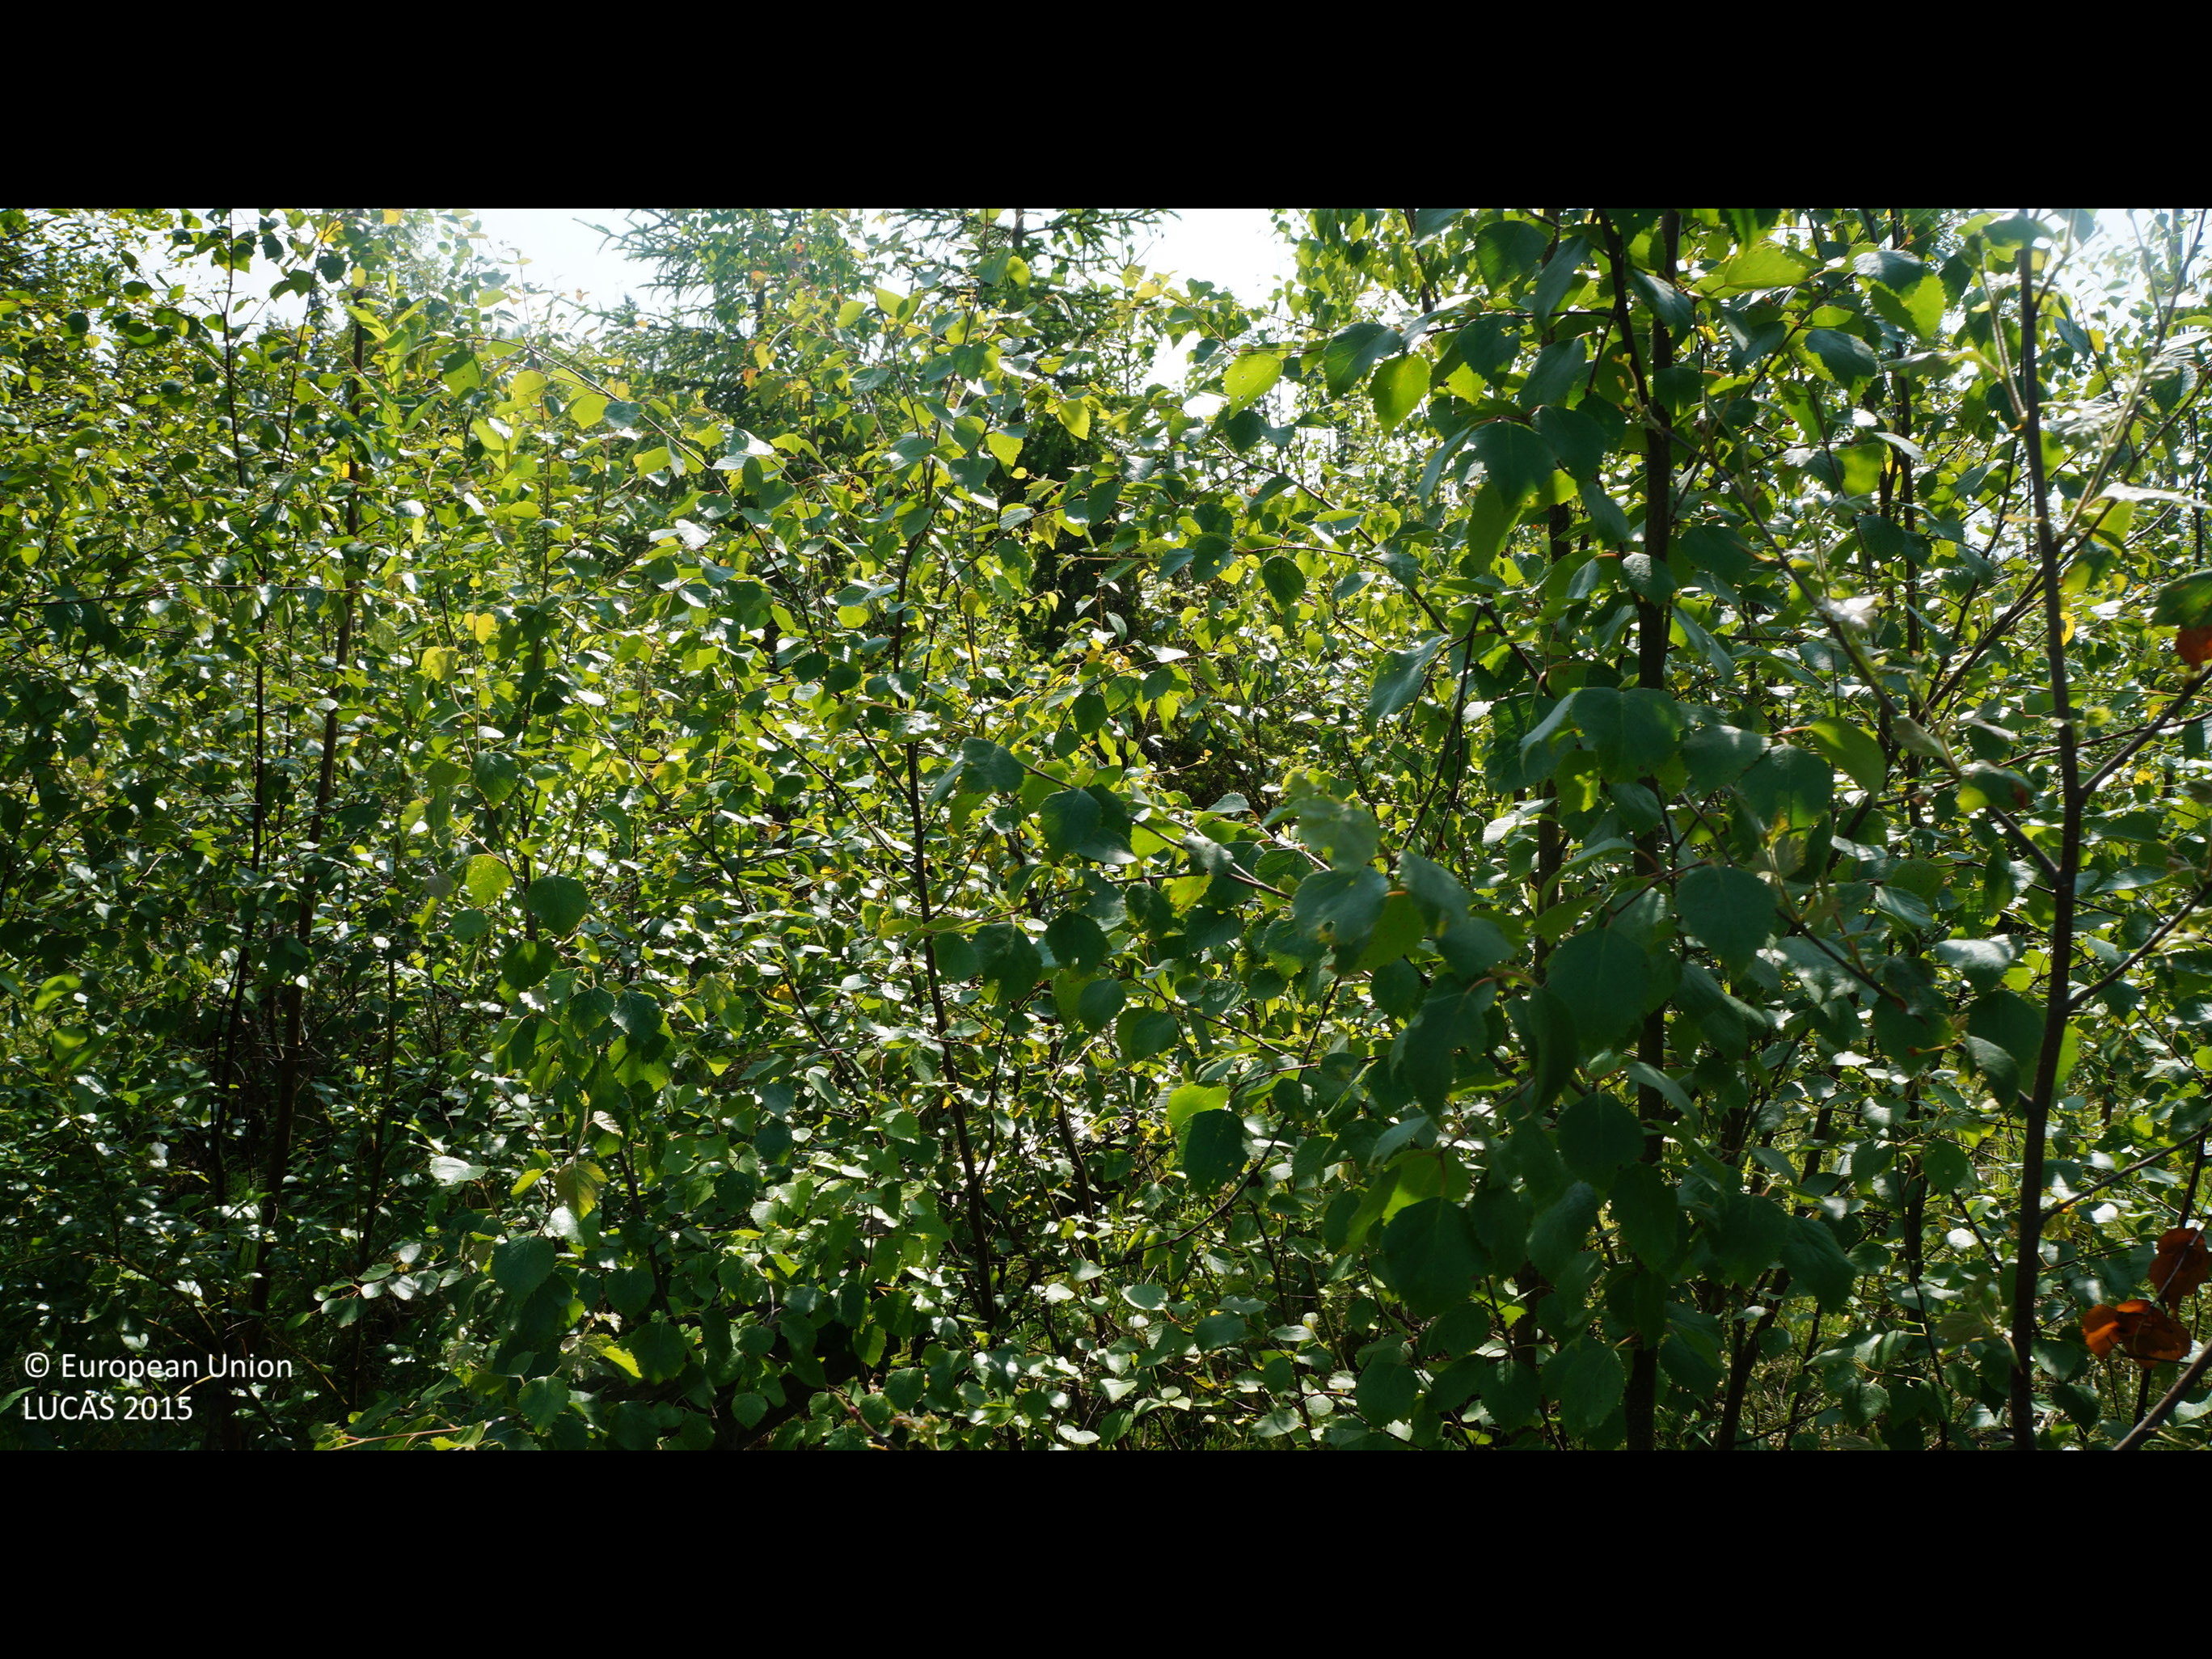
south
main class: Woodland
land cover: Broadleaved woodland
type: boreal forest
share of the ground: 25 - 50 %
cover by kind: shrubs 50 %, broadleaved forest trees 30 %, coniferous forest trees 10 %, herbaceous plants 10 %
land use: Forestry
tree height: < 5 m
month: July
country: FI
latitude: 64.1953
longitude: 24.4220
